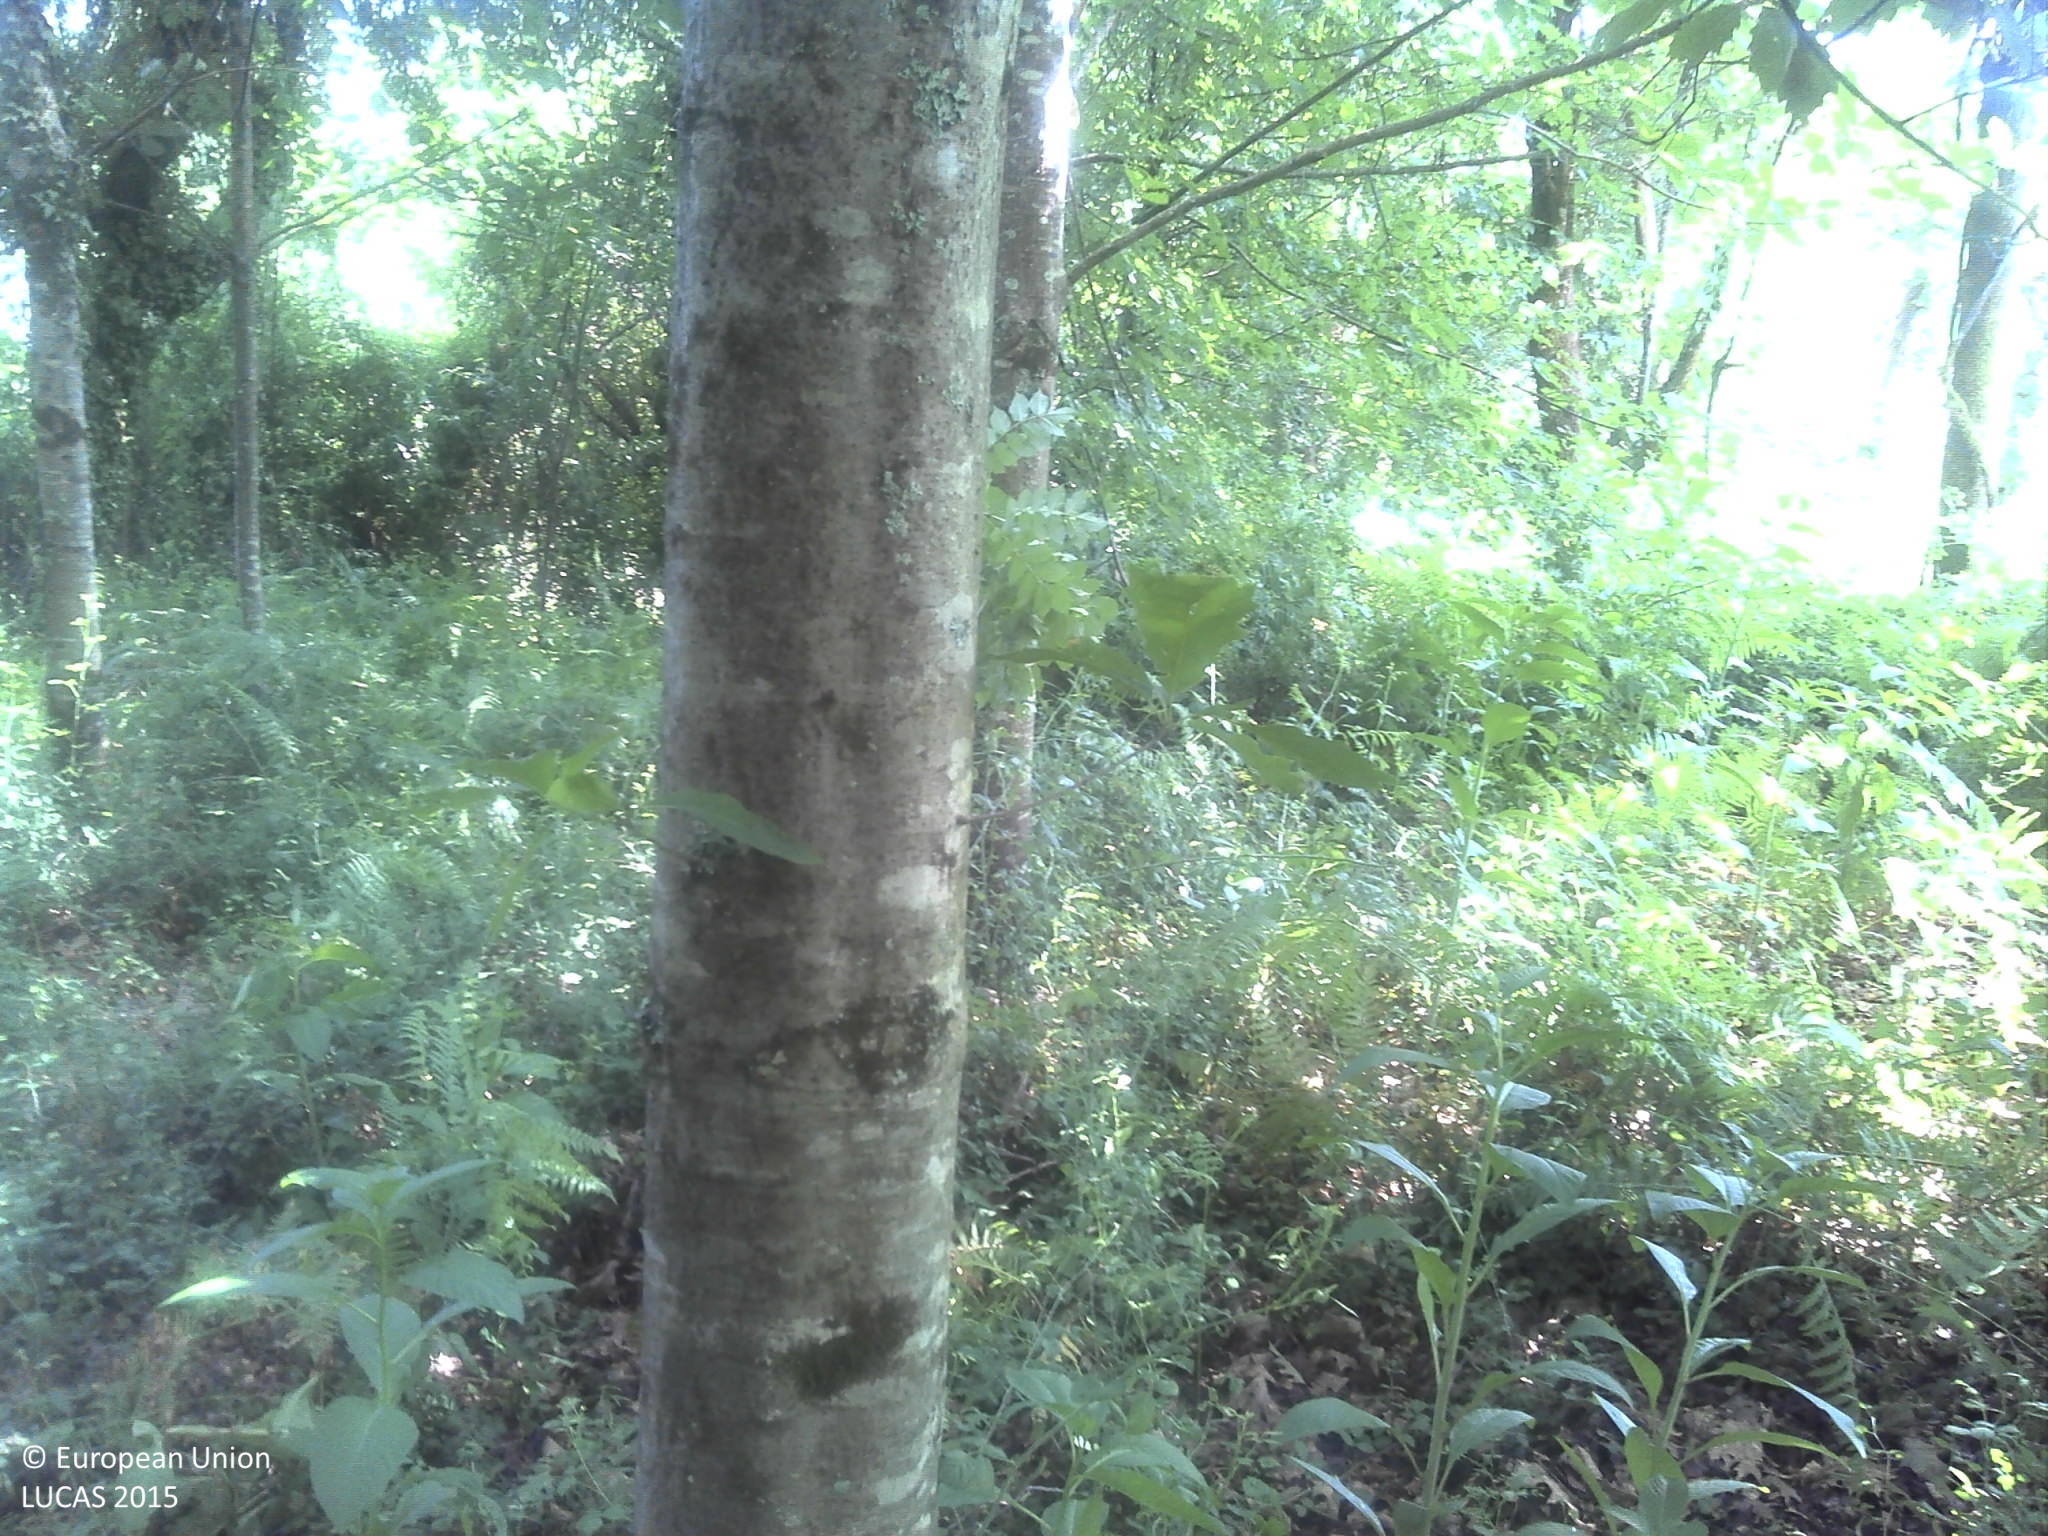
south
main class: Woodland
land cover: Broadleaved woodland
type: acidophilous oak and oak-birch forest
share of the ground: > 75 %
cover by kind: broadleaved forest trees 70 %, shrubs 20 %, herbaceous plants 10 %
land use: Forestry
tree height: > 5 m
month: June
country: PT
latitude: 41.6978
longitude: -8.3587
